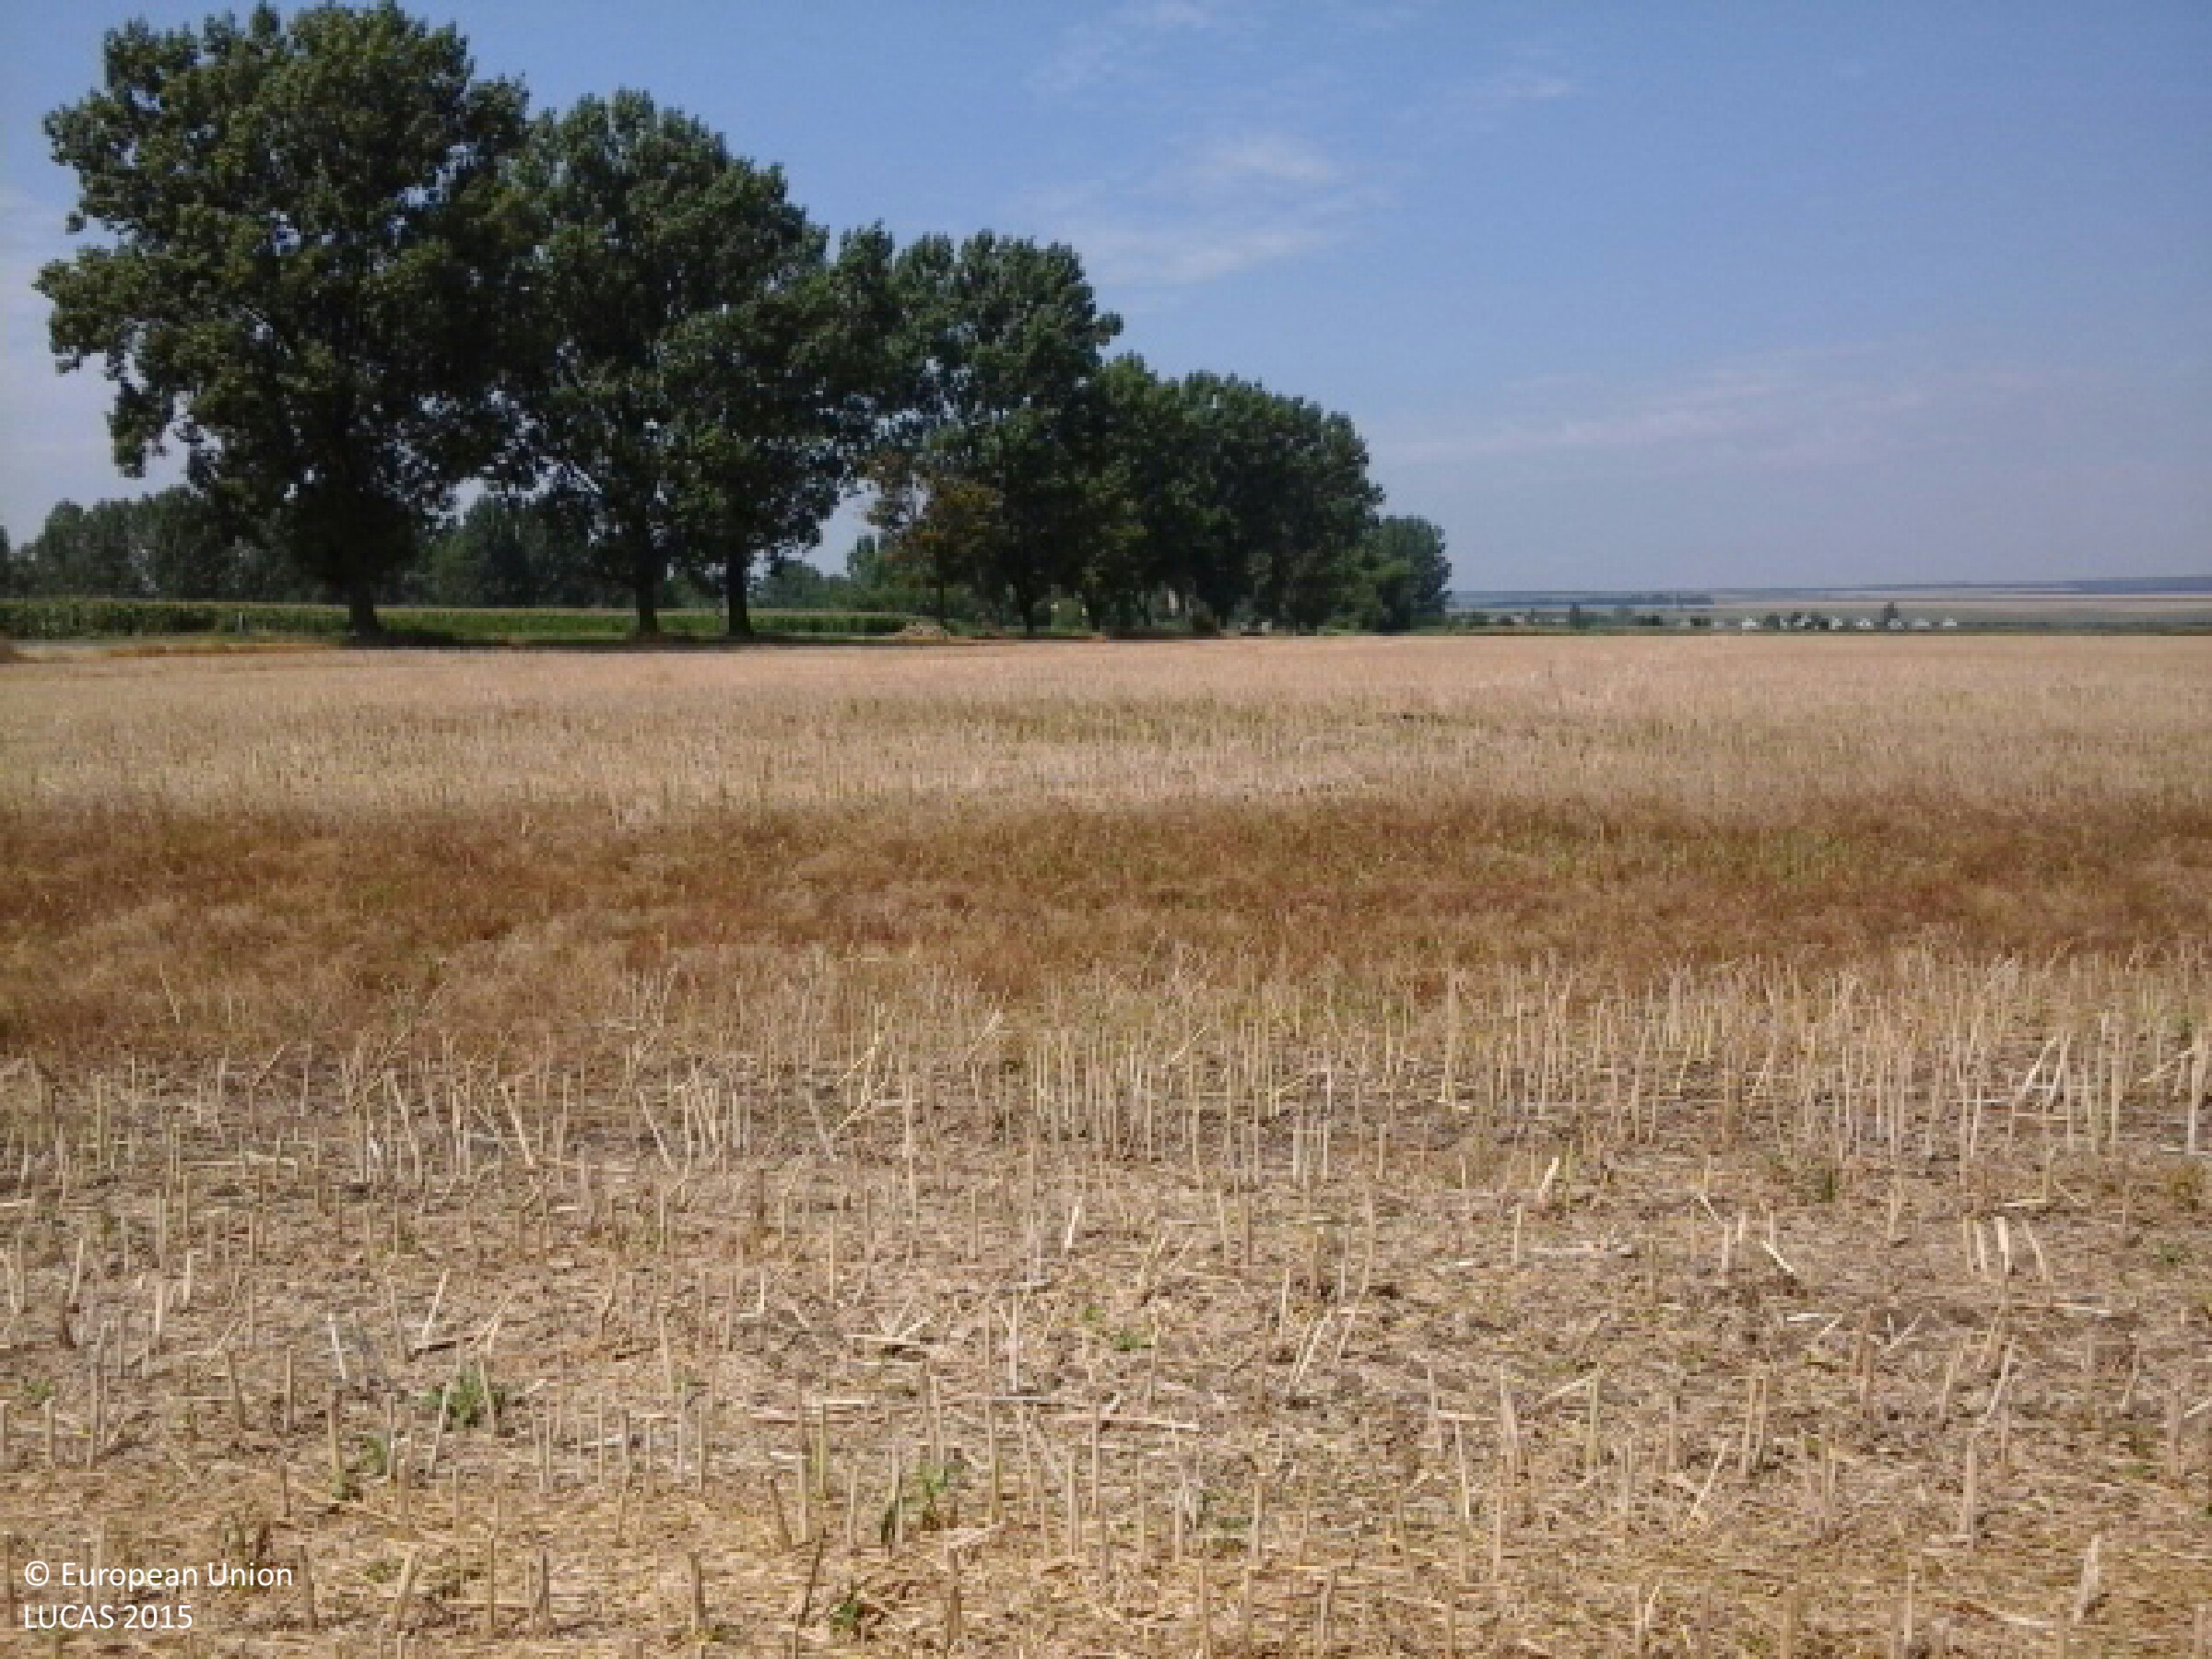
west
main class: Cropland
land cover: Rape and turnip rape
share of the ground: < 10 %
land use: Agriculture (excluding fallow land and kitchen gardens)
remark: Harvested field
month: July
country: HU
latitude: 48.3287
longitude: 21.1427
